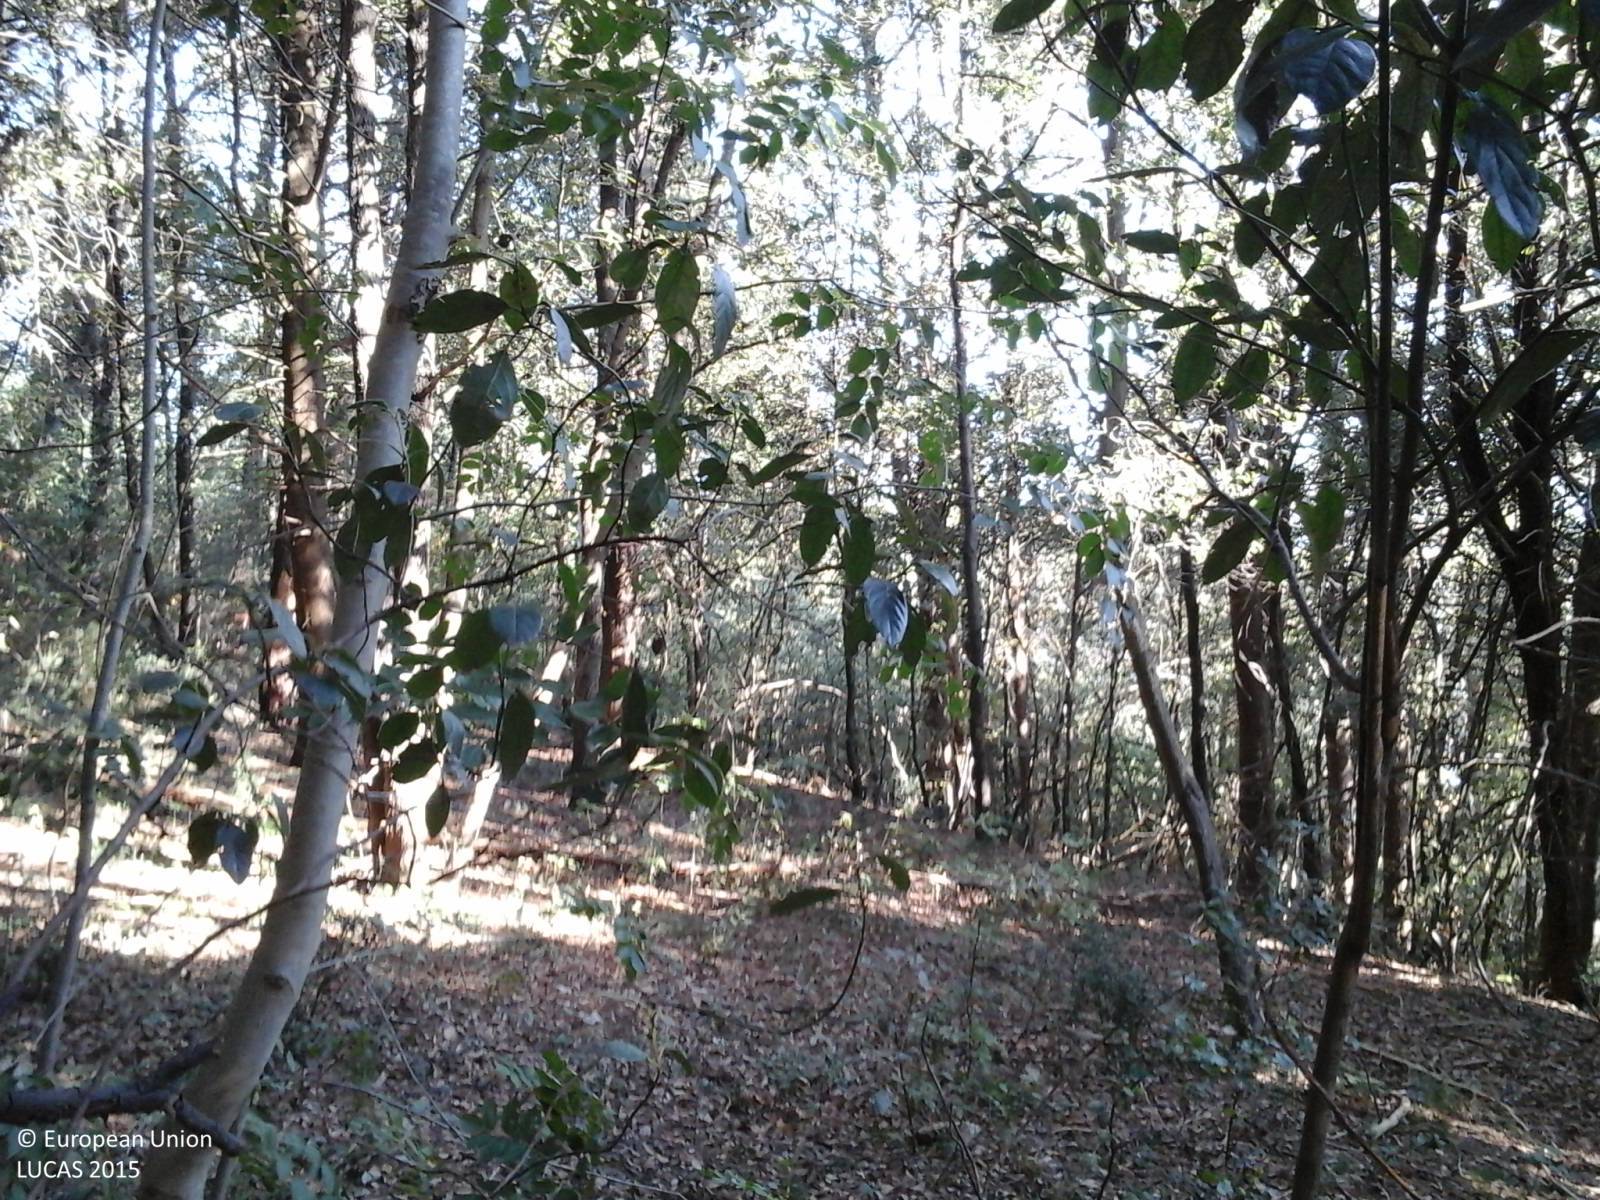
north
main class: Woodland
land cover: Other mixed woodland
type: thermophilous deciduous forest
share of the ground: > 75 %
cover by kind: coniferous forest trees 60 %, broadleaved forest trees 40 %
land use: Forestry
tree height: > 5 m
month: September
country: IT
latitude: 43.0967
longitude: 12.3398
